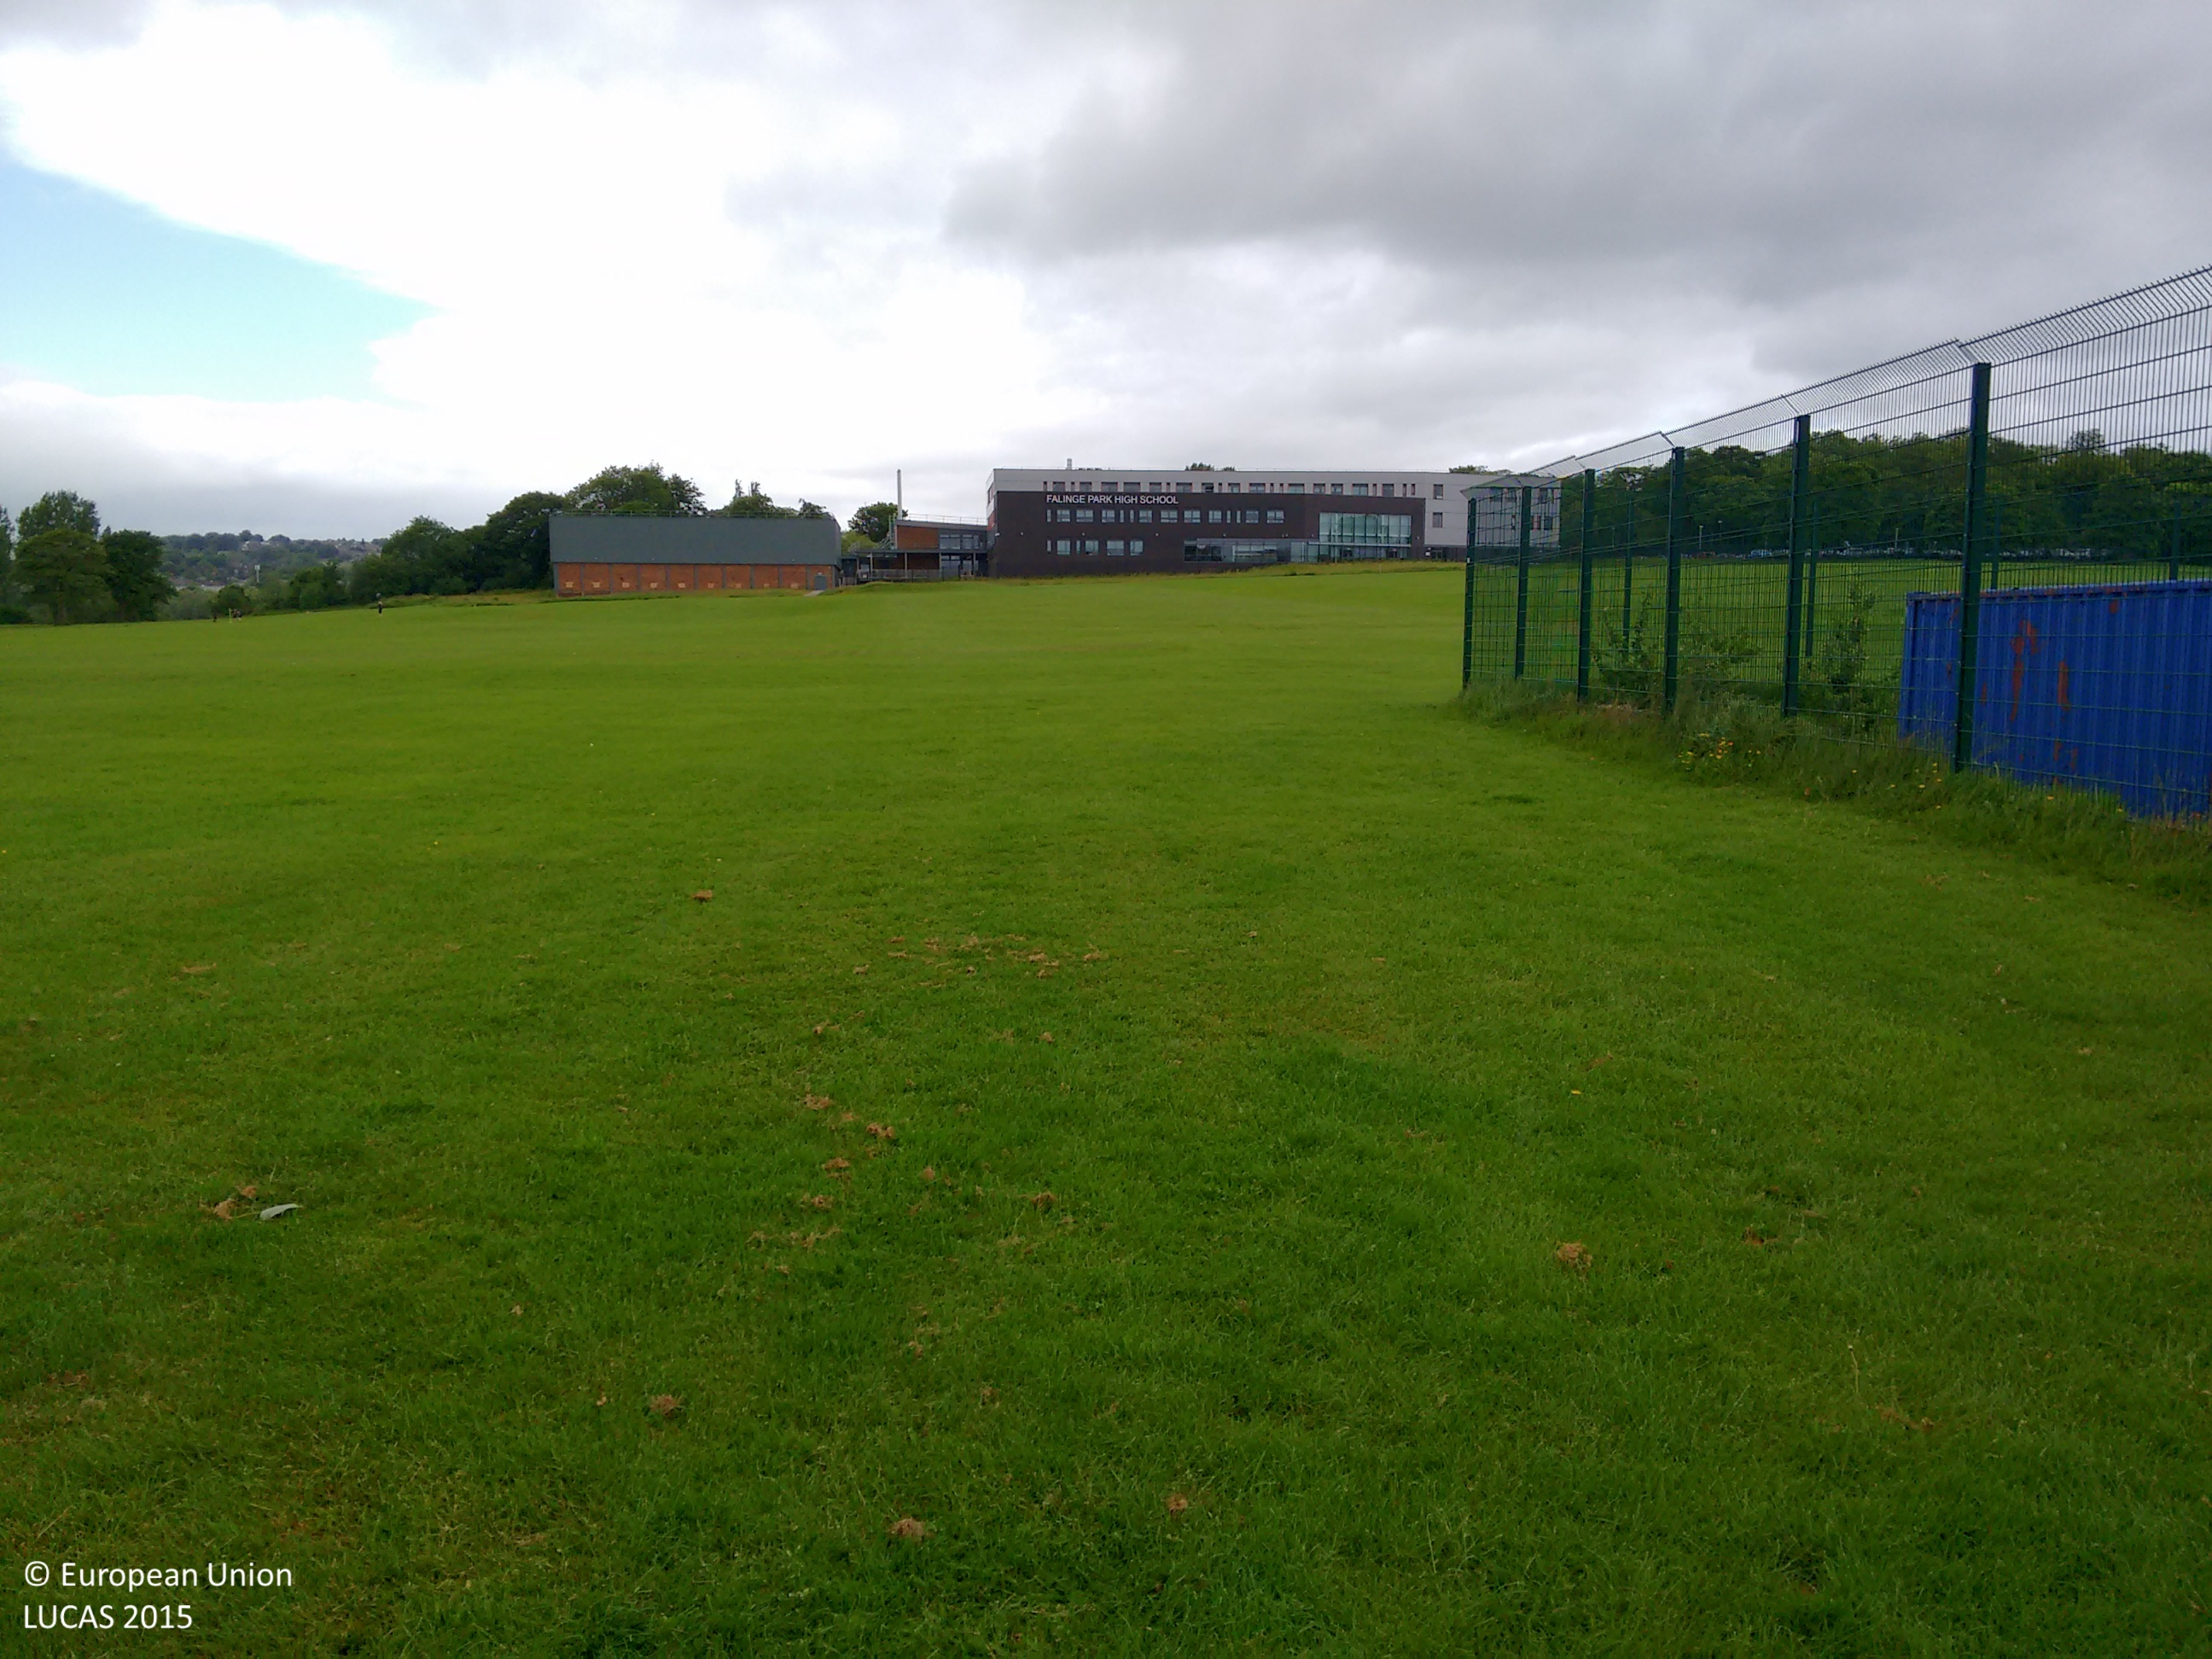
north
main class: Grassland
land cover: Grassland without tree/shrub cover
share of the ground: > 75 %
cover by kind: herbaceous plants 100 %
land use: Sport
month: June
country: GB
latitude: 53.6221
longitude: -2.1702
